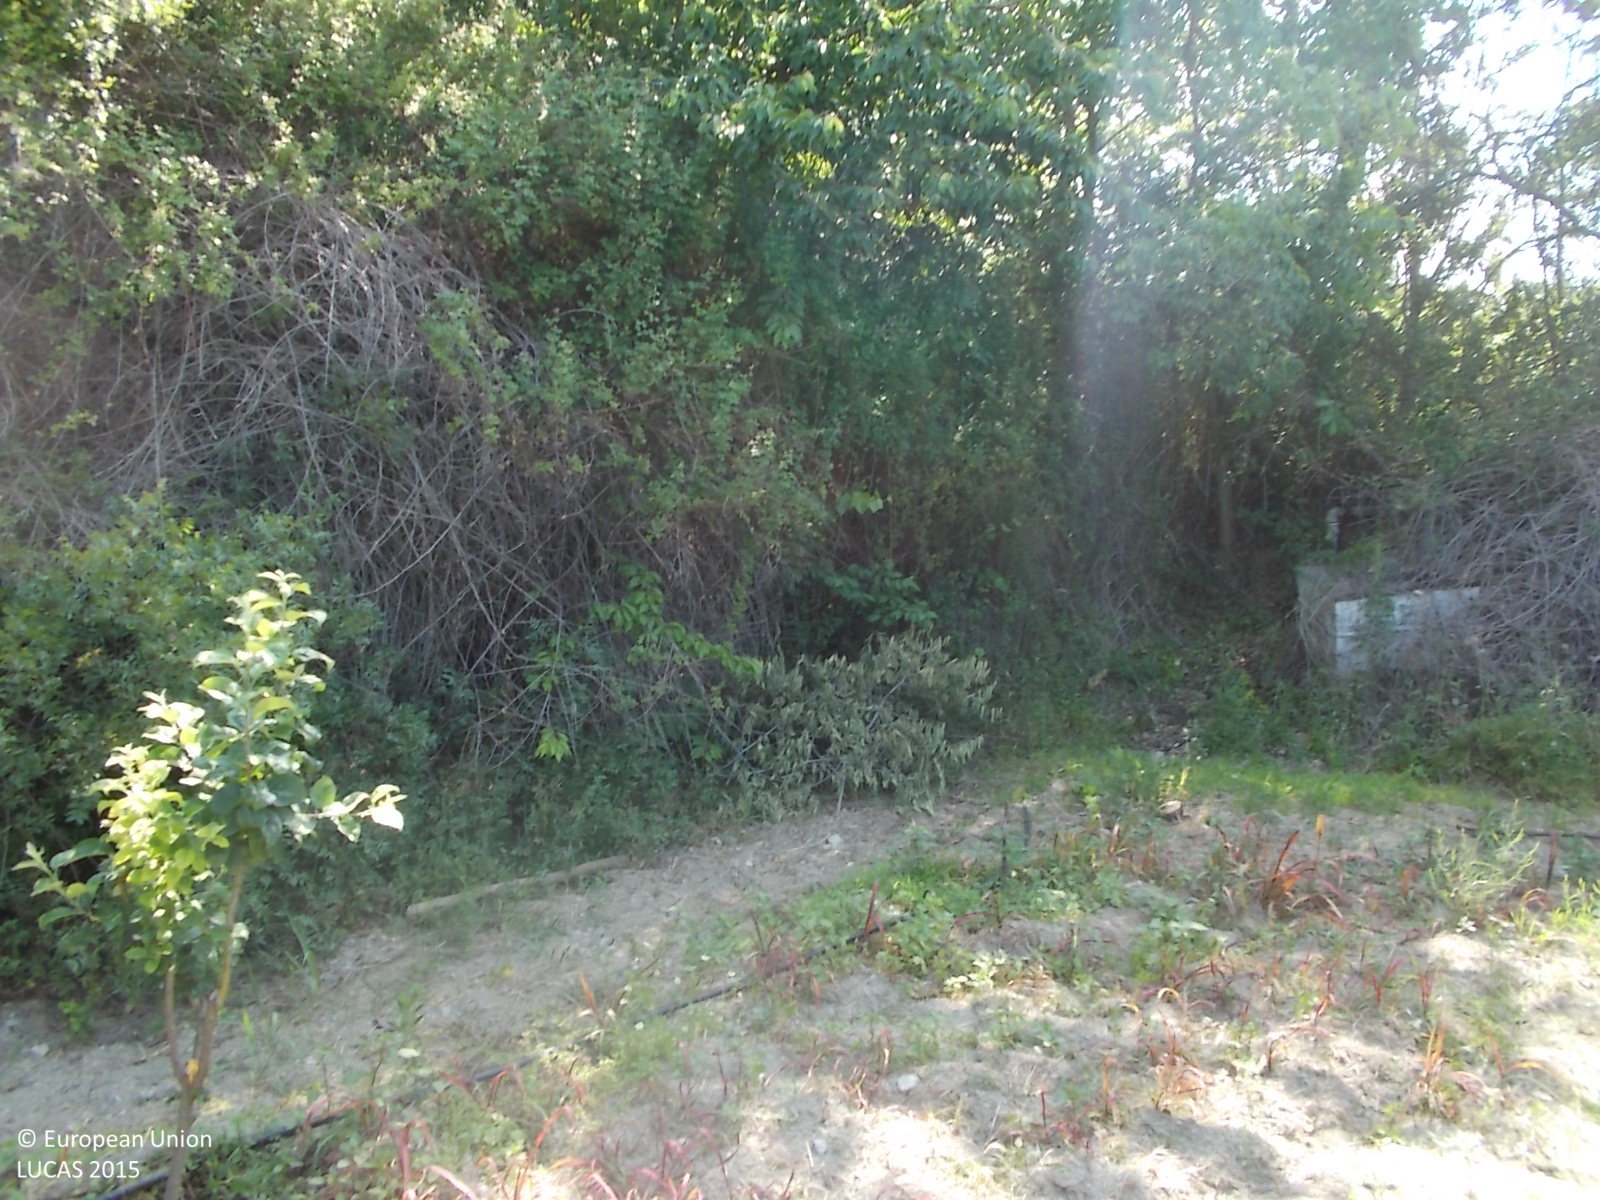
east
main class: Cropland
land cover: Apple fruit
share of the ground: 25 - 50 %
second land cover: Grassland without tree/shrub cover
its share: 50 - 75 %
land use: Agriculture (excluding fallow land and kitchen gardens)
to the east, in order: Apple fruit; Grassland without tree/shrub cover; Grassland with sparse tree/shrub cover; Pine dominated coniferous woodland; Apple fruit; Tracks; Broadleaved woodland; Artificial constructions in urban areas; Broadleaved woodland; Tracks; Nuts trees
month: June
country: CY
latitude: 34.8945
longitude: 32.8260
